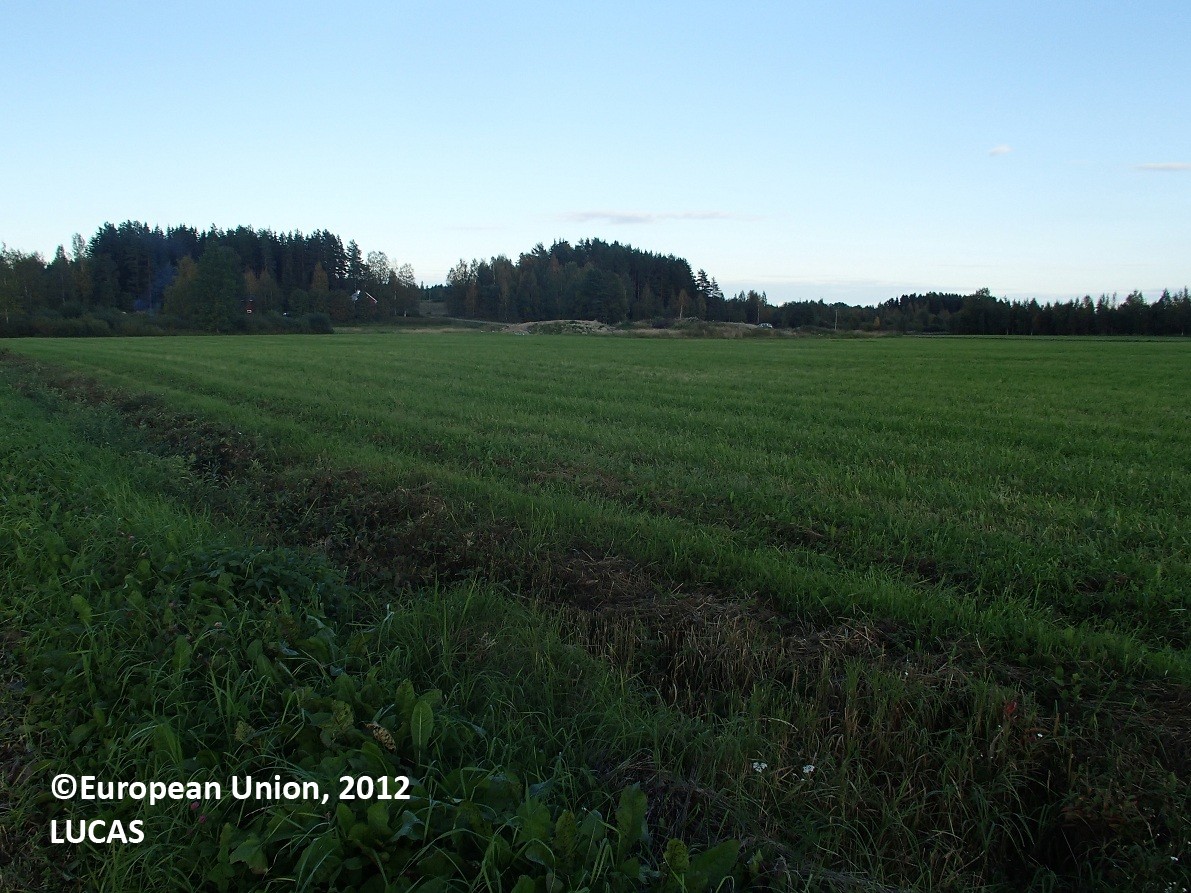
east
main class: Cropland
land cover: Temporary grasslands
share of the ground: > 75 %
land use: Agriculture (excluding fallow land and kitchen gardens)
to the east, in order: Temporary grasslands; Grass margins; Ditches and canals; Grass margins; Temporary grasslands; Grass margins; Ditches and canals; Grass margins; Temporary grasslands
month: August
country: FI
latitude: 63.5813
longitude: 27.0012
